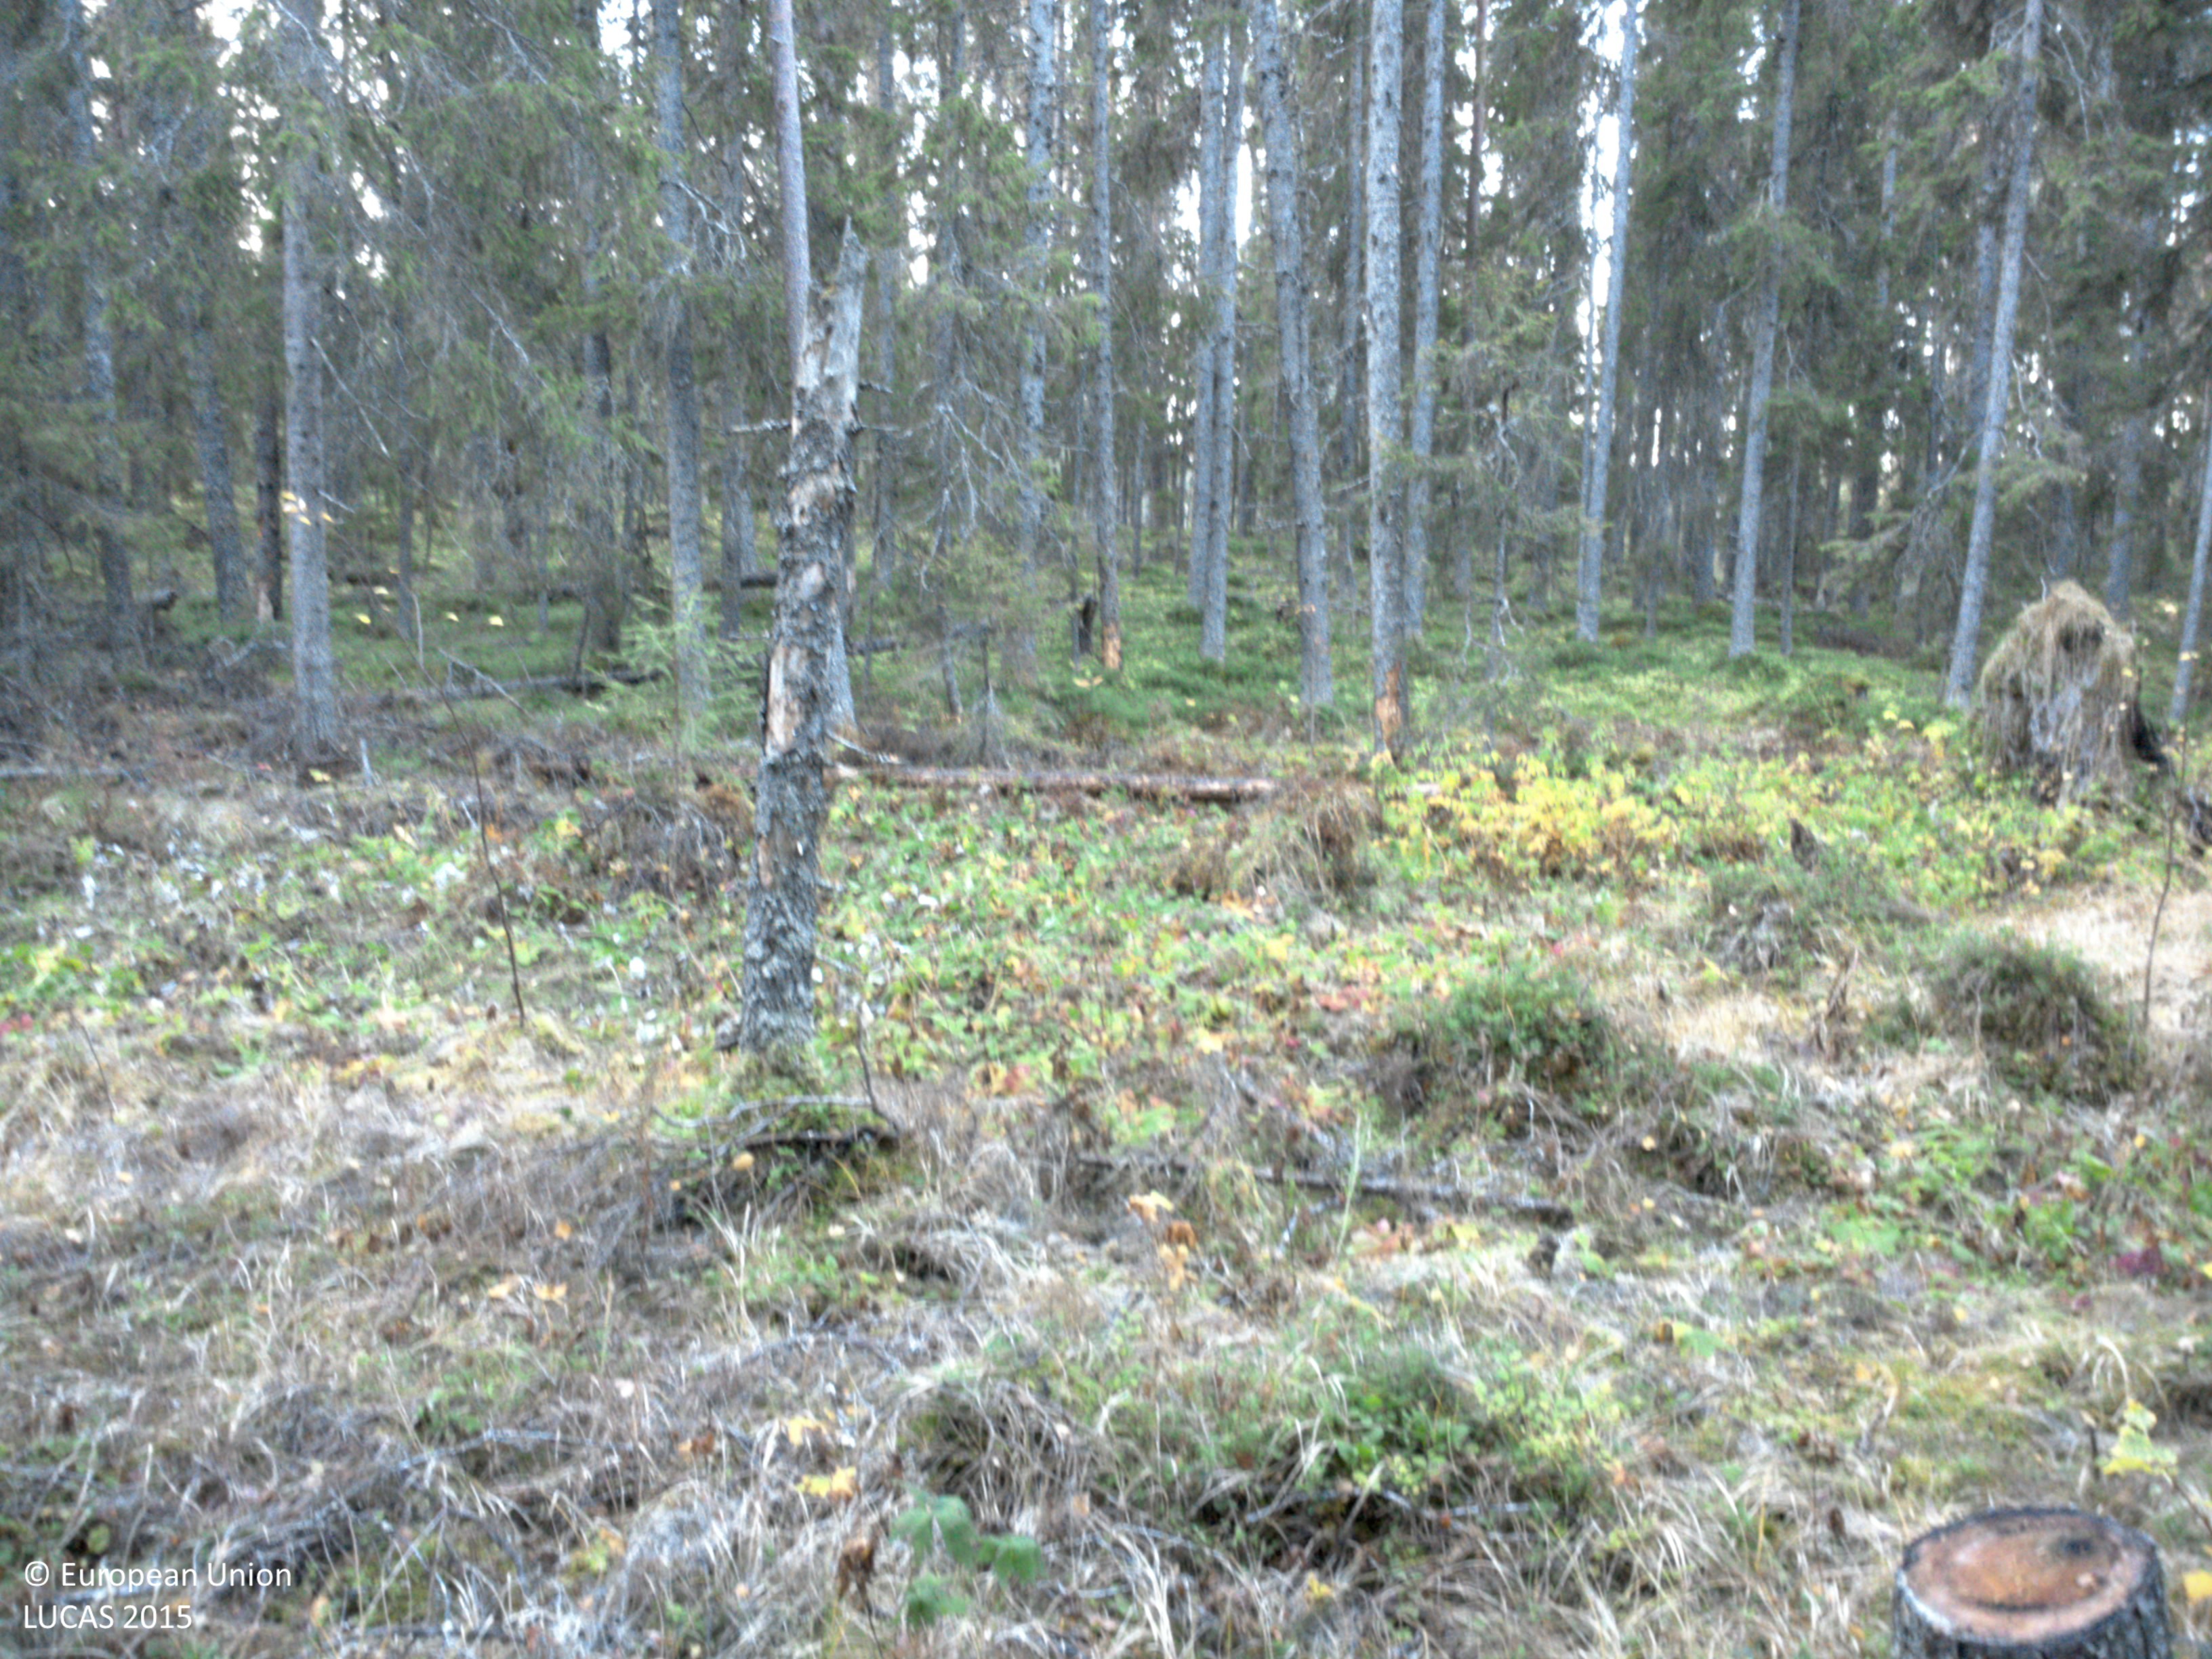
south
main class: Woodland
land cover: Spruce dominated coniferous woodland
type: boreal forest
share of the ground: 25 - 50 %
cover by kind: coniferous forest trees 50 %, herbaceous plants 30 %, shrubs 10 %, lichens and mosses 10 %
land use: Forestry
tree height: > 5 m
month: October
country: SE
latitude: 64.8744
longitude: 17.8799
